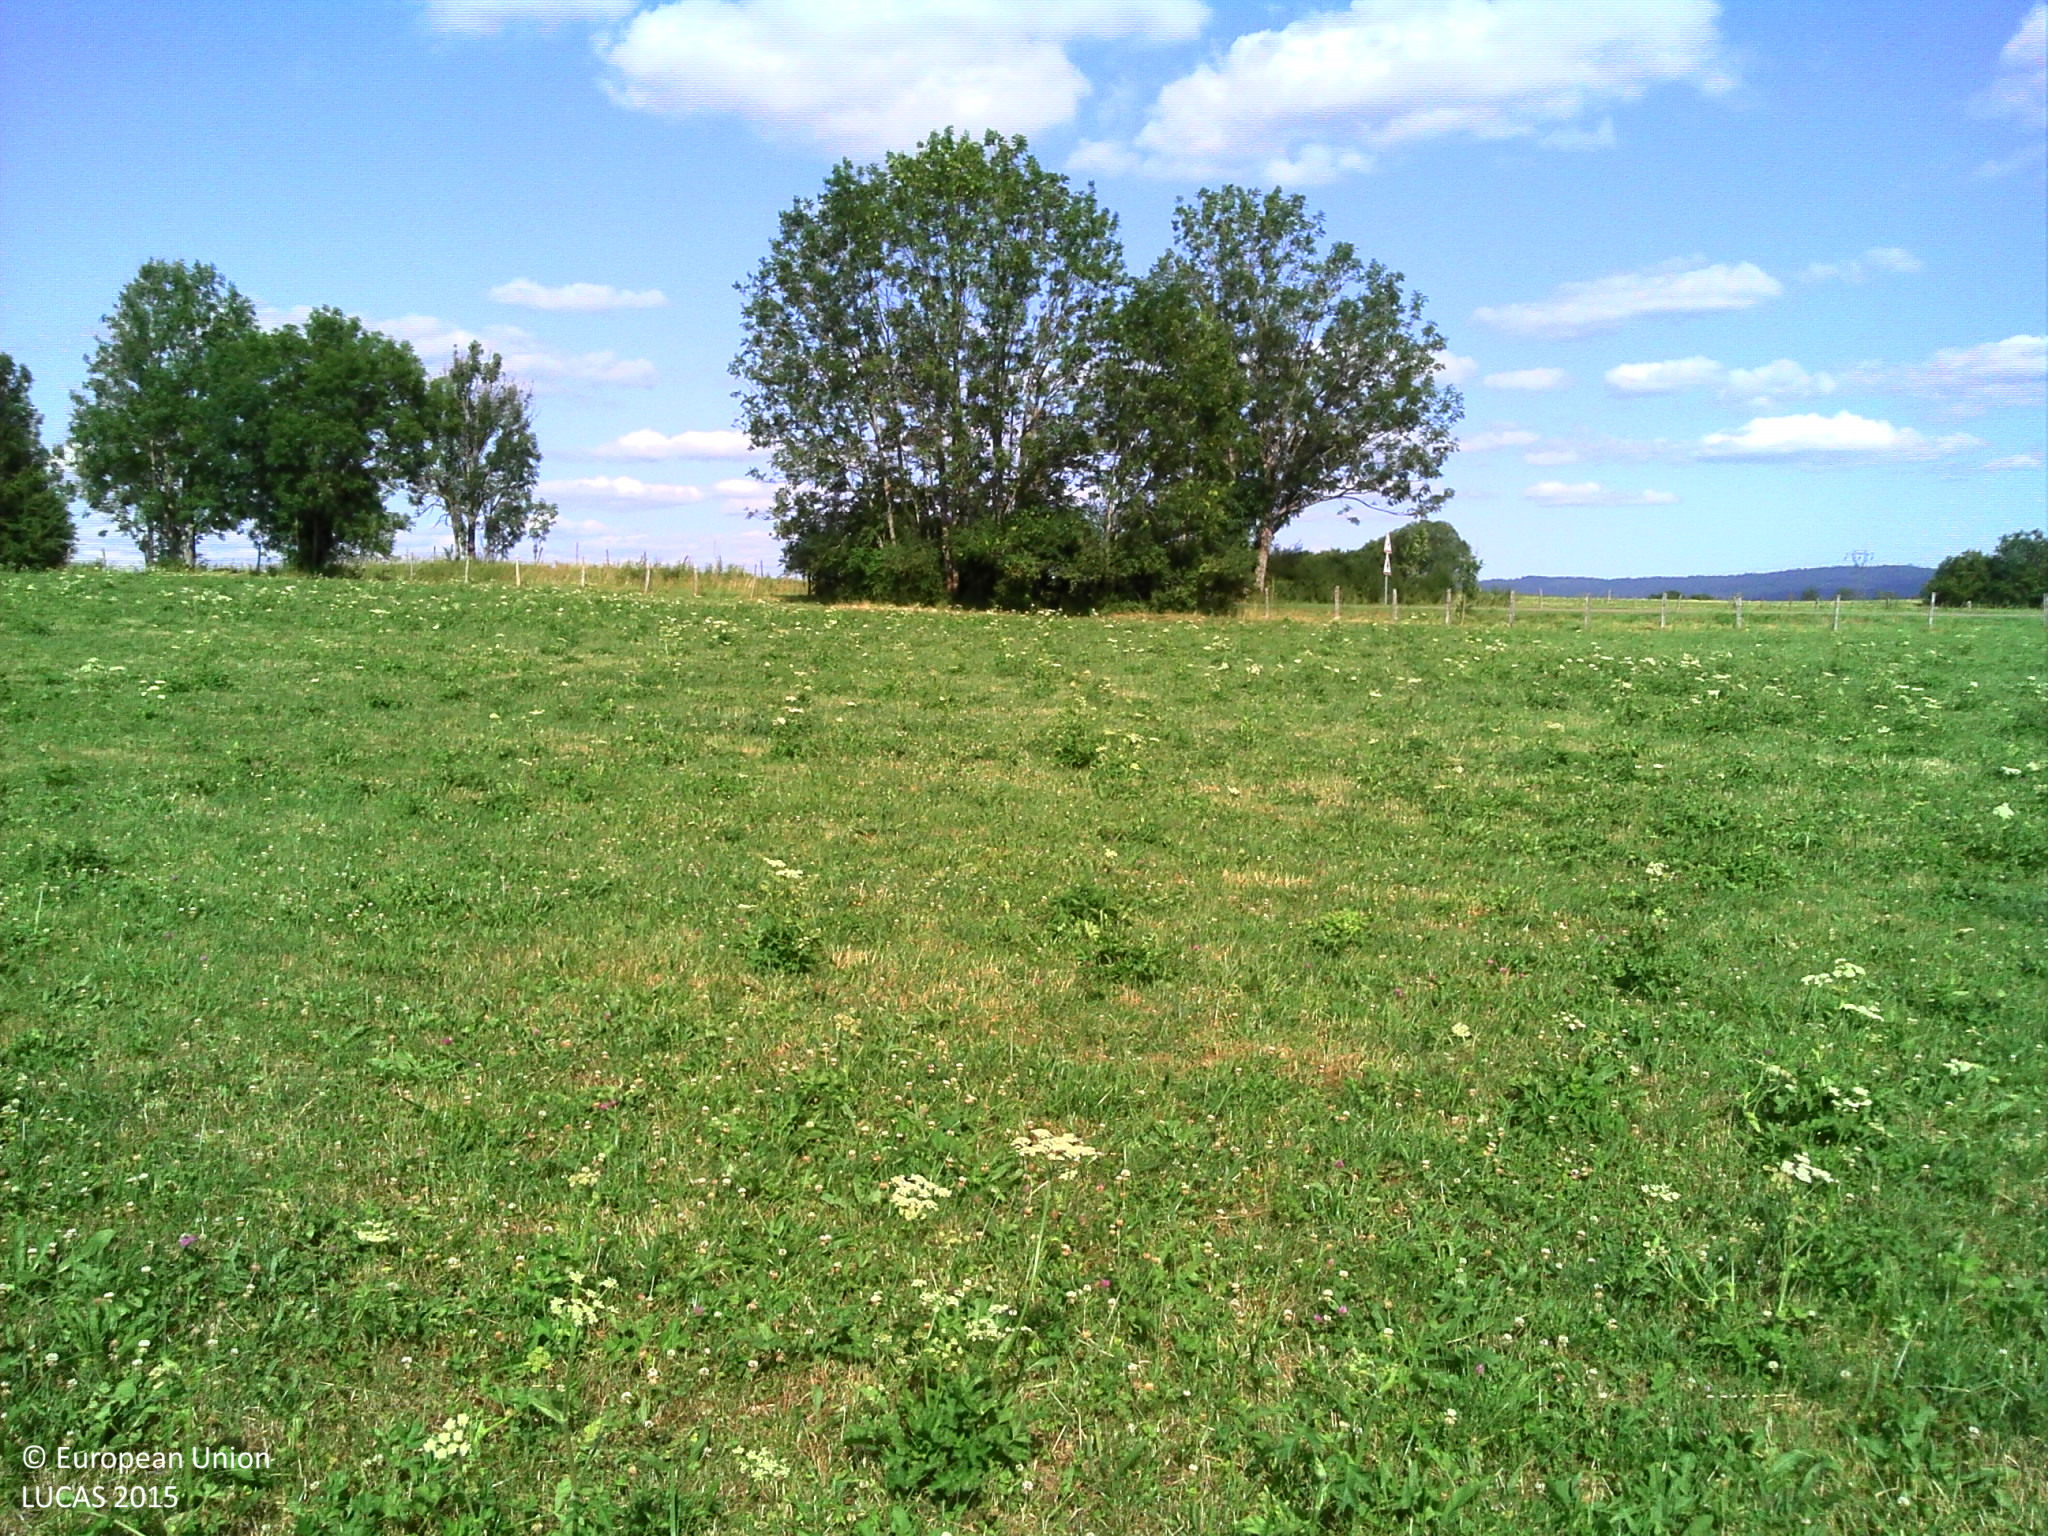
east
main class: Grassland
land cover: Grassland without tree/shrub cover
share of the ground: > 75 %
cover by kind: herbaceous plants 100 %
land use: Agriculture (excluding fallow land and kitchen gardens)
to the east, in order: Grassland without tree/shrub cover; Fences; Grass margins; Paved roads, cycling and walking lanes; Grass margins; Single bushes/trees; Fences; Abandoned hedges; Grassland without tree/shrub cover; Grass margins; Paved roads, cycling and walking lanes
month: July
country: FR
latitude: 46.8015
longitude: 6.0585
